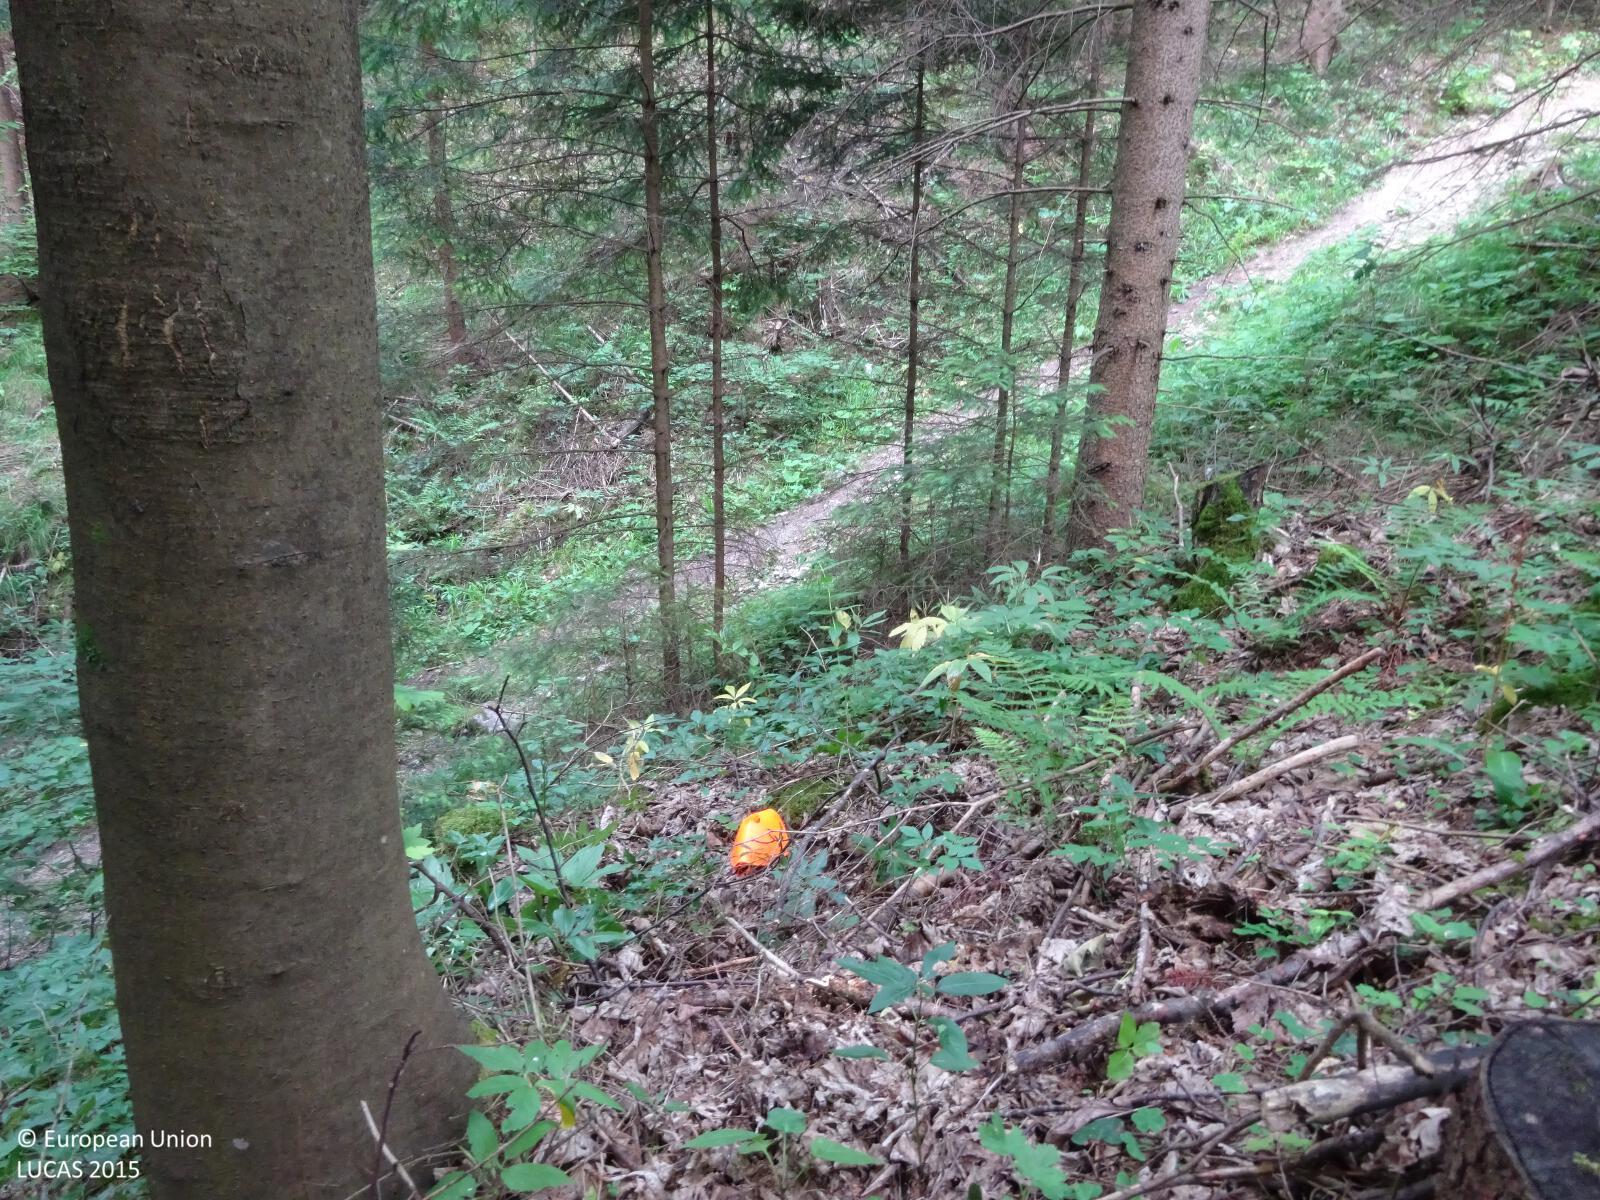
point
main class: Woodland
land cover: Spruce dominated coniferous woodland
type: alpine coniferous forest
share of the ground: > 75 %
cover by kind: coniferous forest trees 90 %, broadleaved forest trees 10 %
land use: Forestry
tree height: > 5 m
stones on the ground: < 10 %
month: June
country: AT
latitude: 47.6548
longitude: 15.8204
